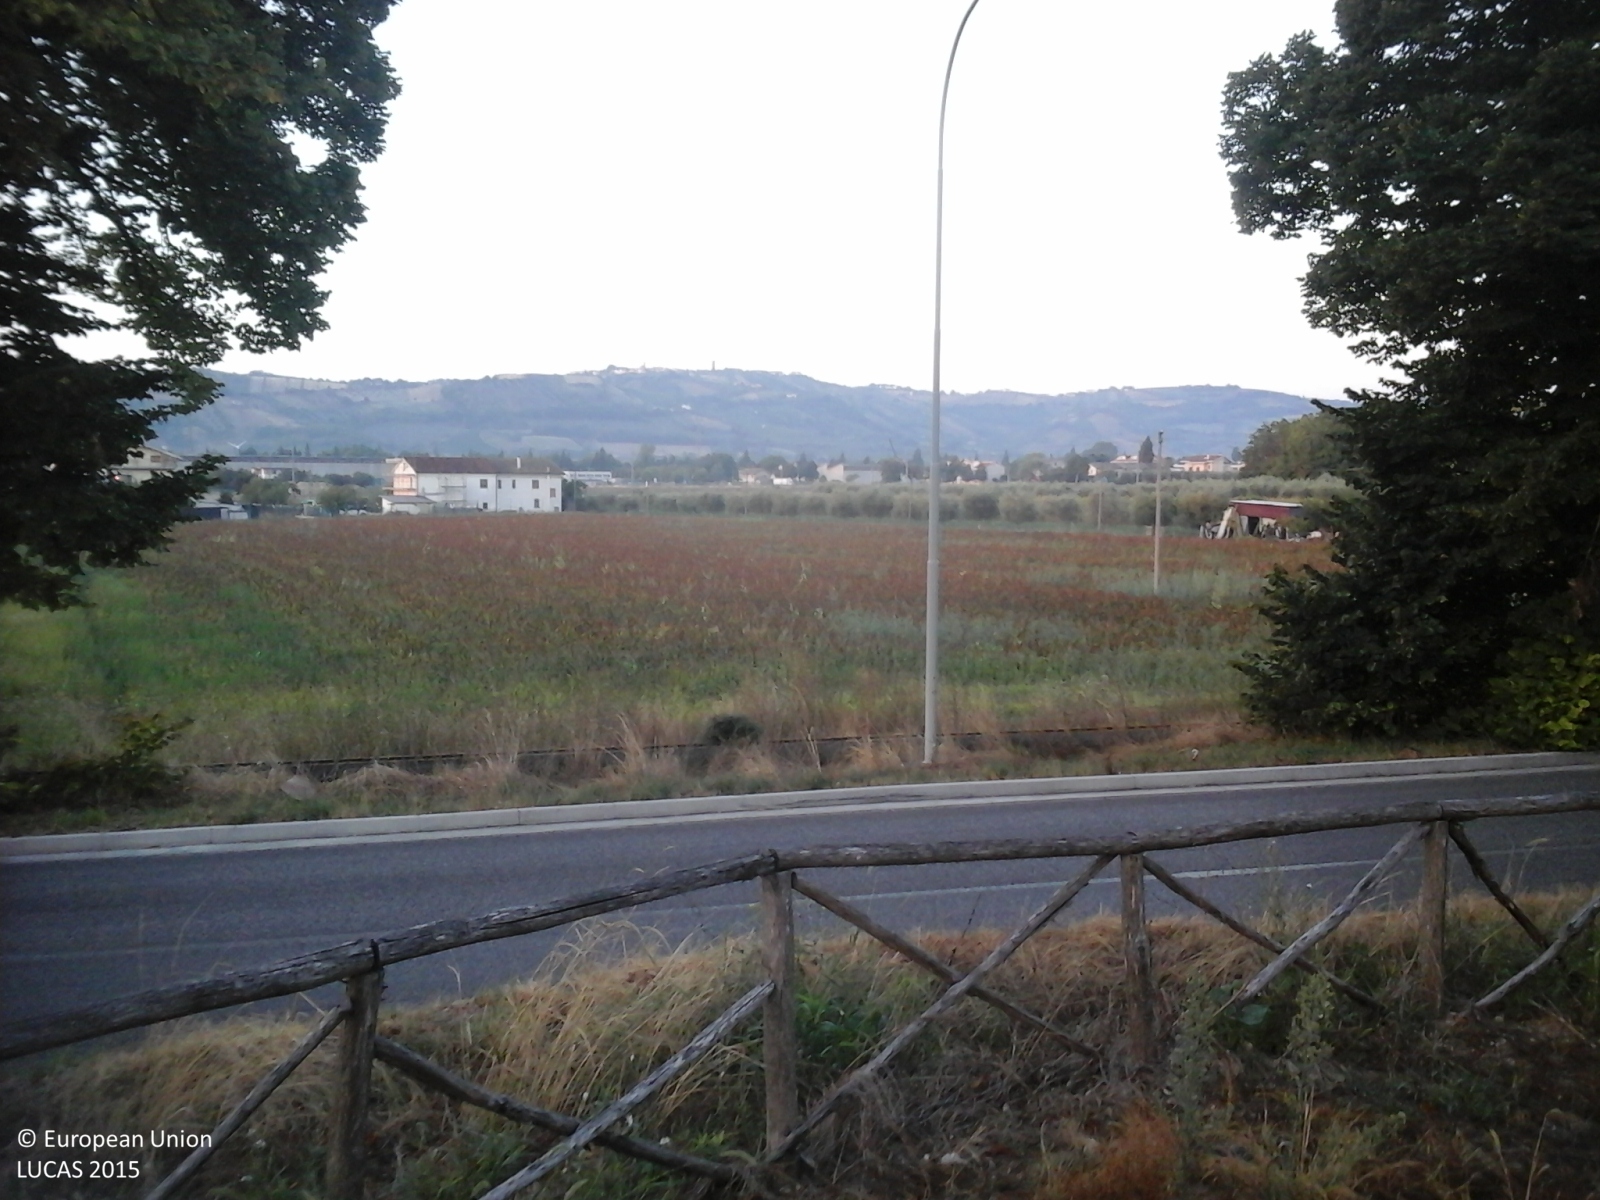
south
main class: Grassland
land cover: Spontaneously vegetated surfaces
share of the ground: > 75 %
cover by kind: herbaceous plants 90 %, unconsolidated bare surface 10 %
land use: Residential
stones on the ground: < 10 %
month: August
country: IT
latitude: 42.8892
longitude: 13.8221
